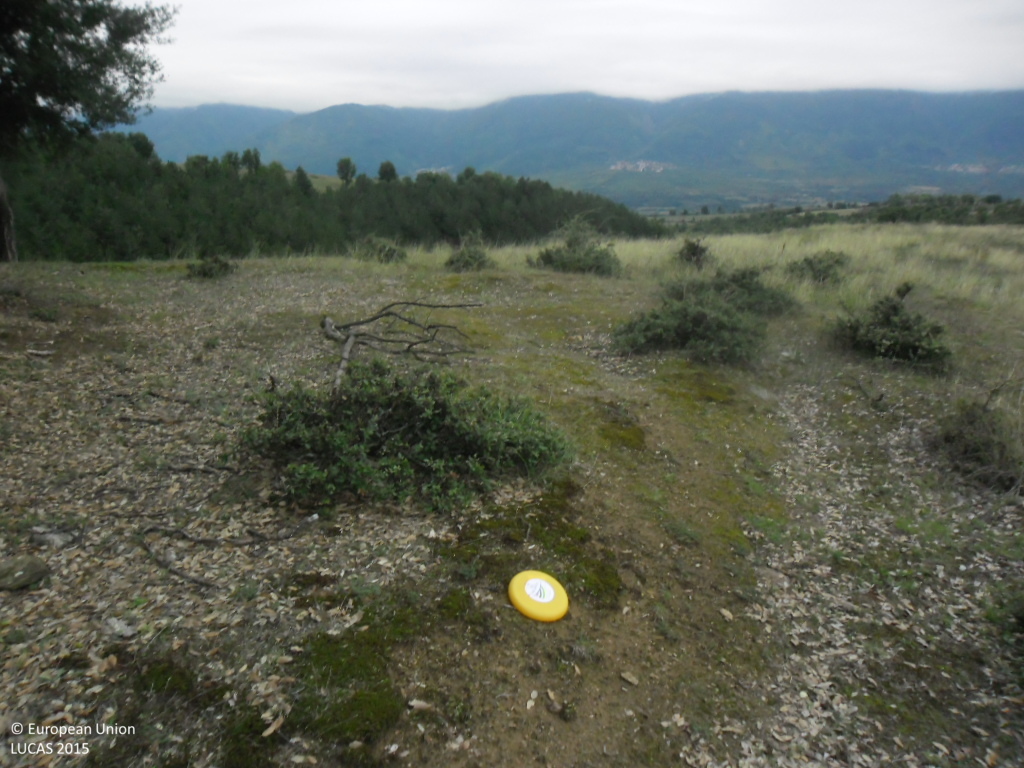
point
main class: Grassland
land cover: Grassland with sparse tree/shrub cover
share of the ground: > 75 %
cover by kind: herbaceous plants 90 %, broadleaved forest trees 5 %, shrubs 5 %
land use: Agriculture (excluding fallow land and kitchen gardens)
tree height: < 5 m
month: September
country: BG
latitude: 41.4223
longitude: 23.0474
